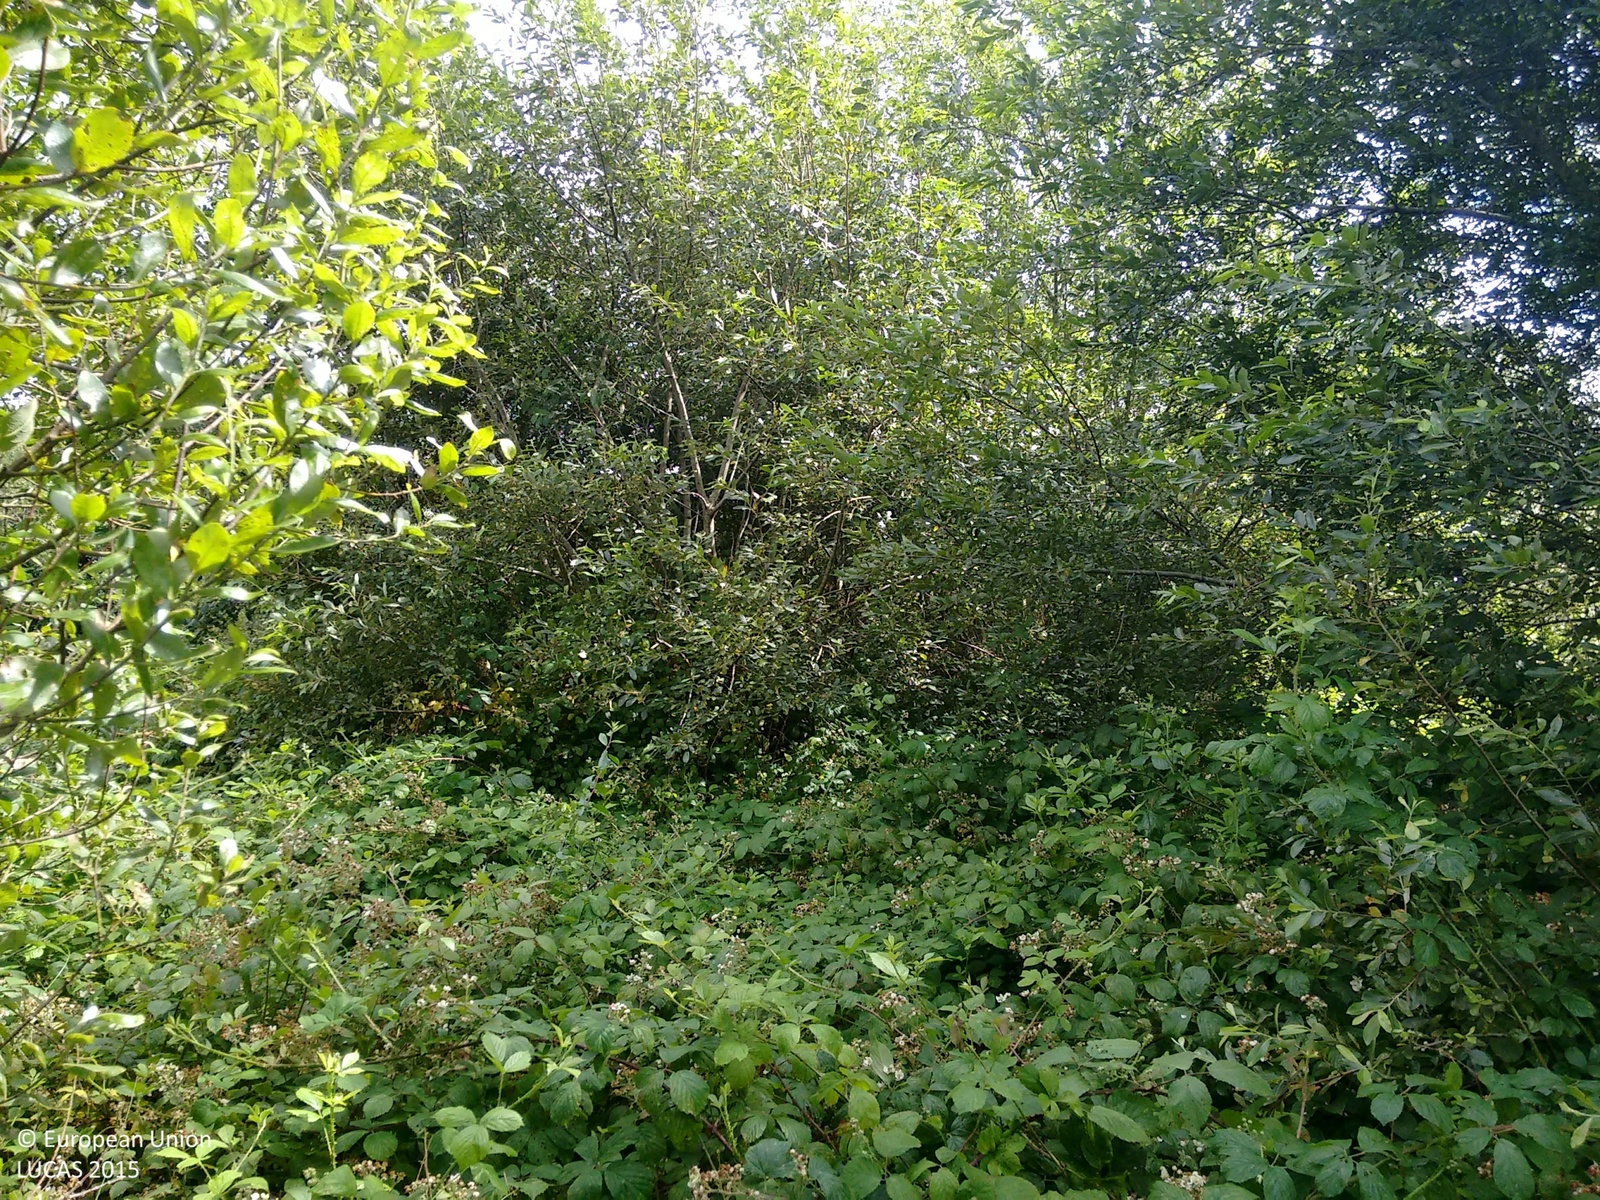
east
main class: Woodland
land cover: Broadleaved woodland
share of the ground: > 75 %
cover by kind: broadleaved forest trees 85 %, shrubs 15 %
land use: Abandoned areas
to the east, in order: Broadleaved woodland; Grassland without tree/shrub cover; Electric lines; Grassland without tree/shrub cover; Shrubland without tree cover; Abandoned hedges; Grassland without tree/shrub cover; Broadleaved woodland; Ditches and canals; Broadleaved woodland; Abandoned hedges; Paved roads, cycling and walking lanes; Fences; Abandoned hedges; Fences; Grassland without tree/shrub cover; Abandoned hedges; Grassland without tree/shrub cover
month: August
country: IE
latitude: 51.7376
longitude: -9.3867
